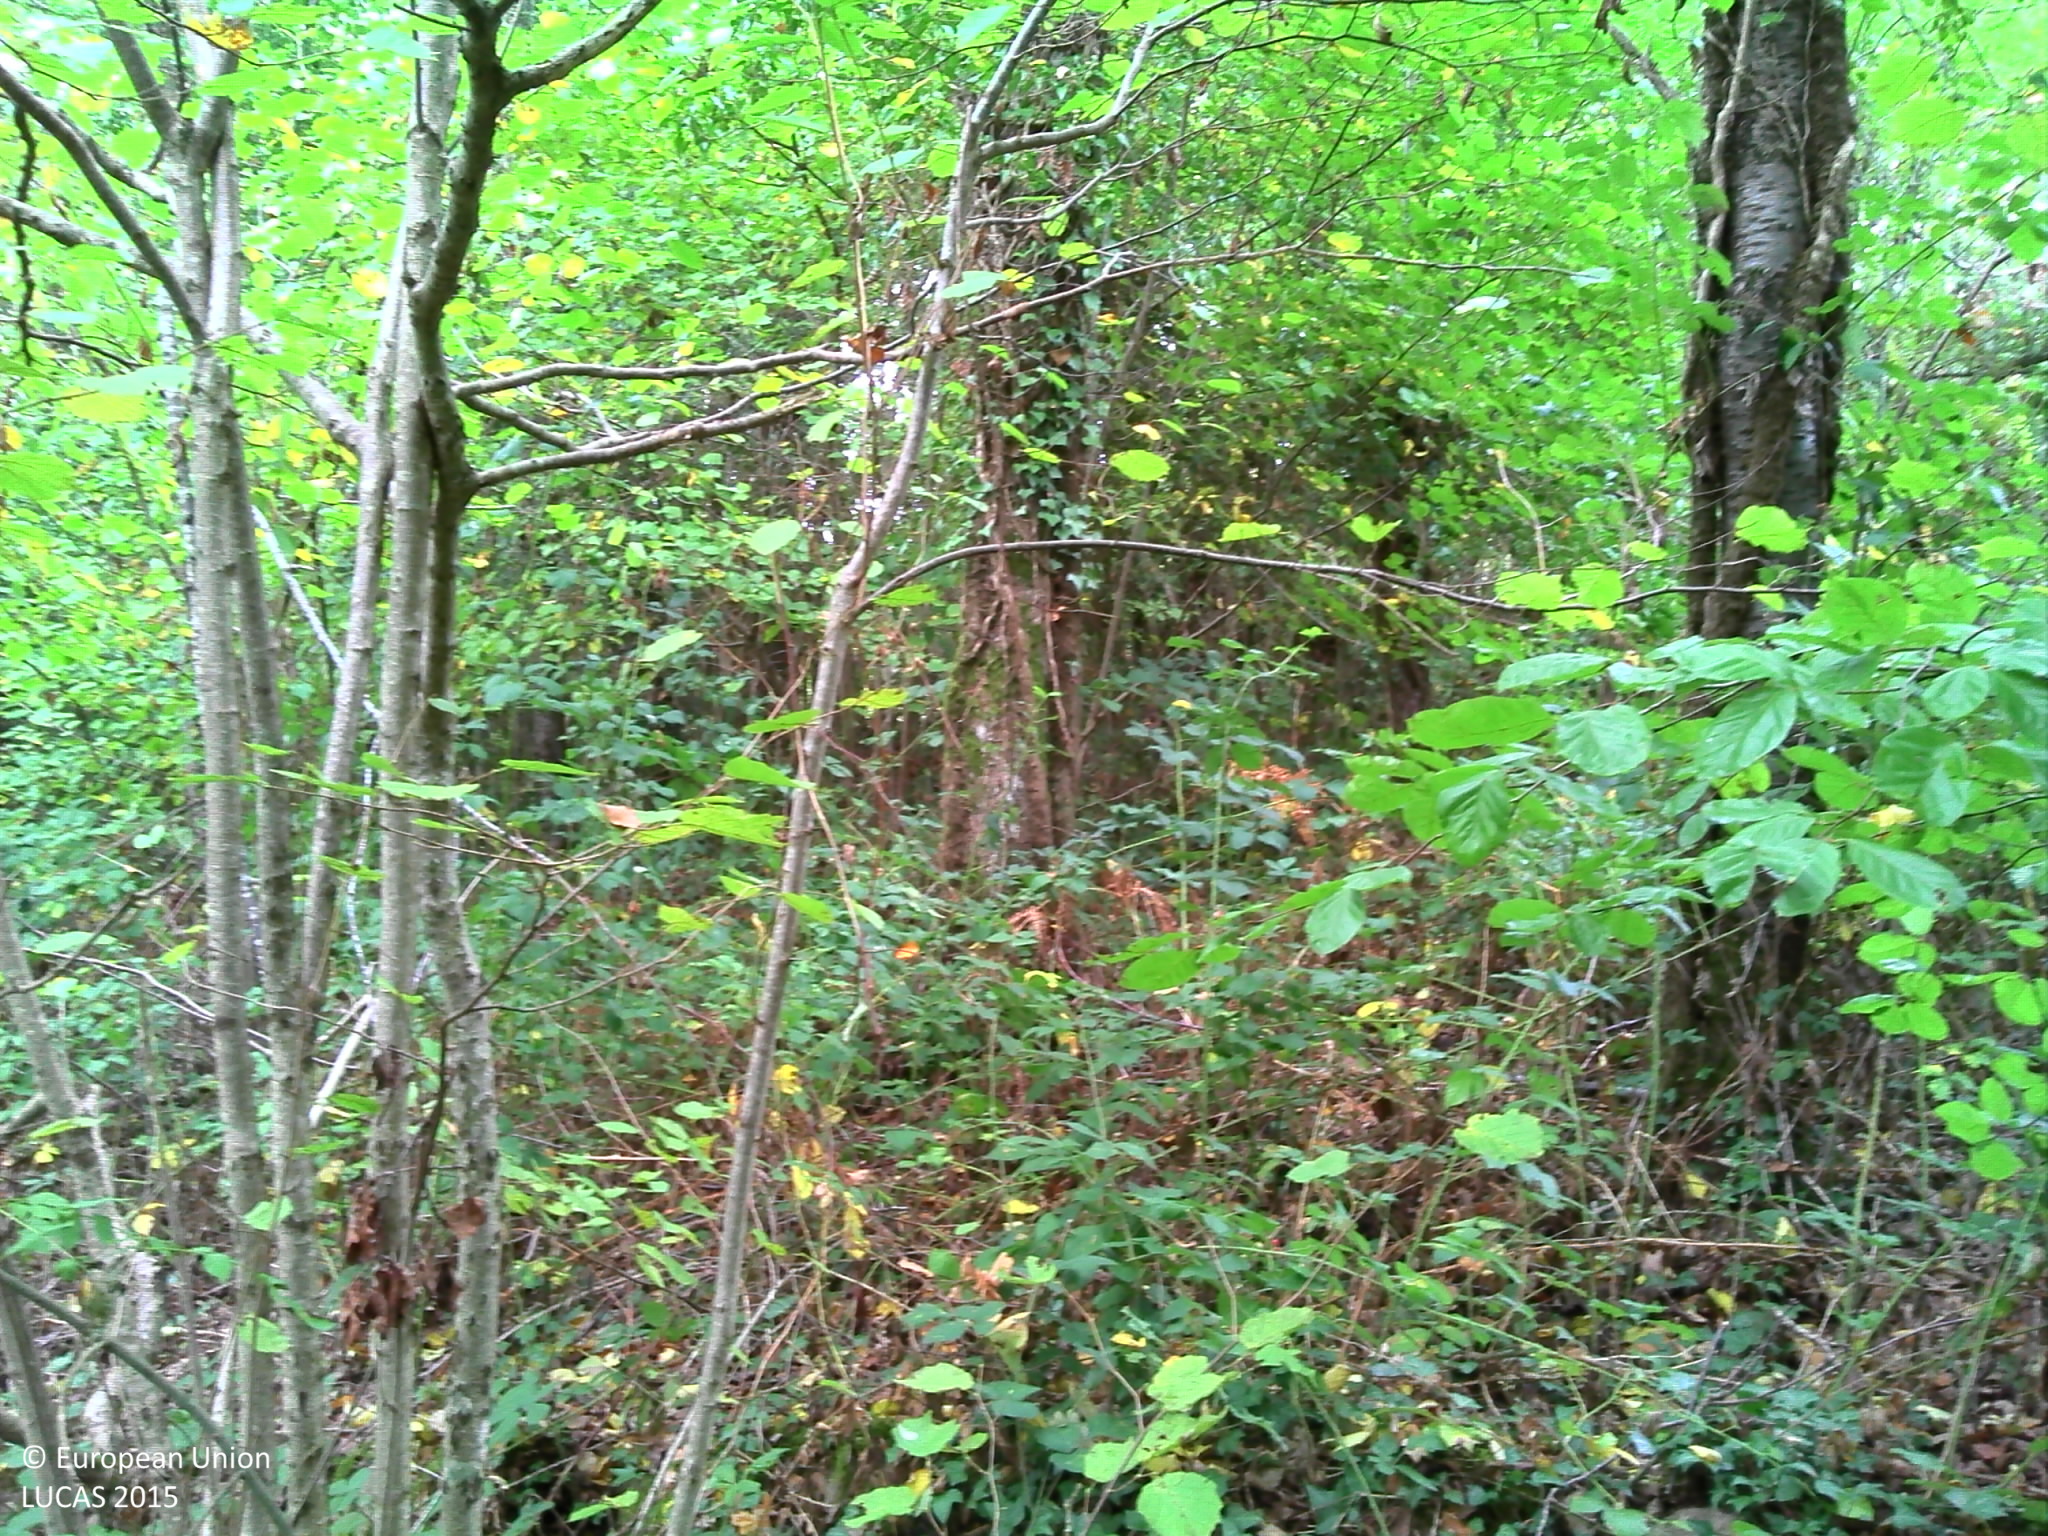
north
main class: Woodland
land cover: Broadleaved woodland
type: beech forest
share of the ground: > 75 %
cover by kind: broadleaved forest trees 90 %, herbaceous plants 10 %
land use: Forestry
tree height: > 5 m
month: September
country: FR
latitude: 46.2188
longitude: 2.8285
